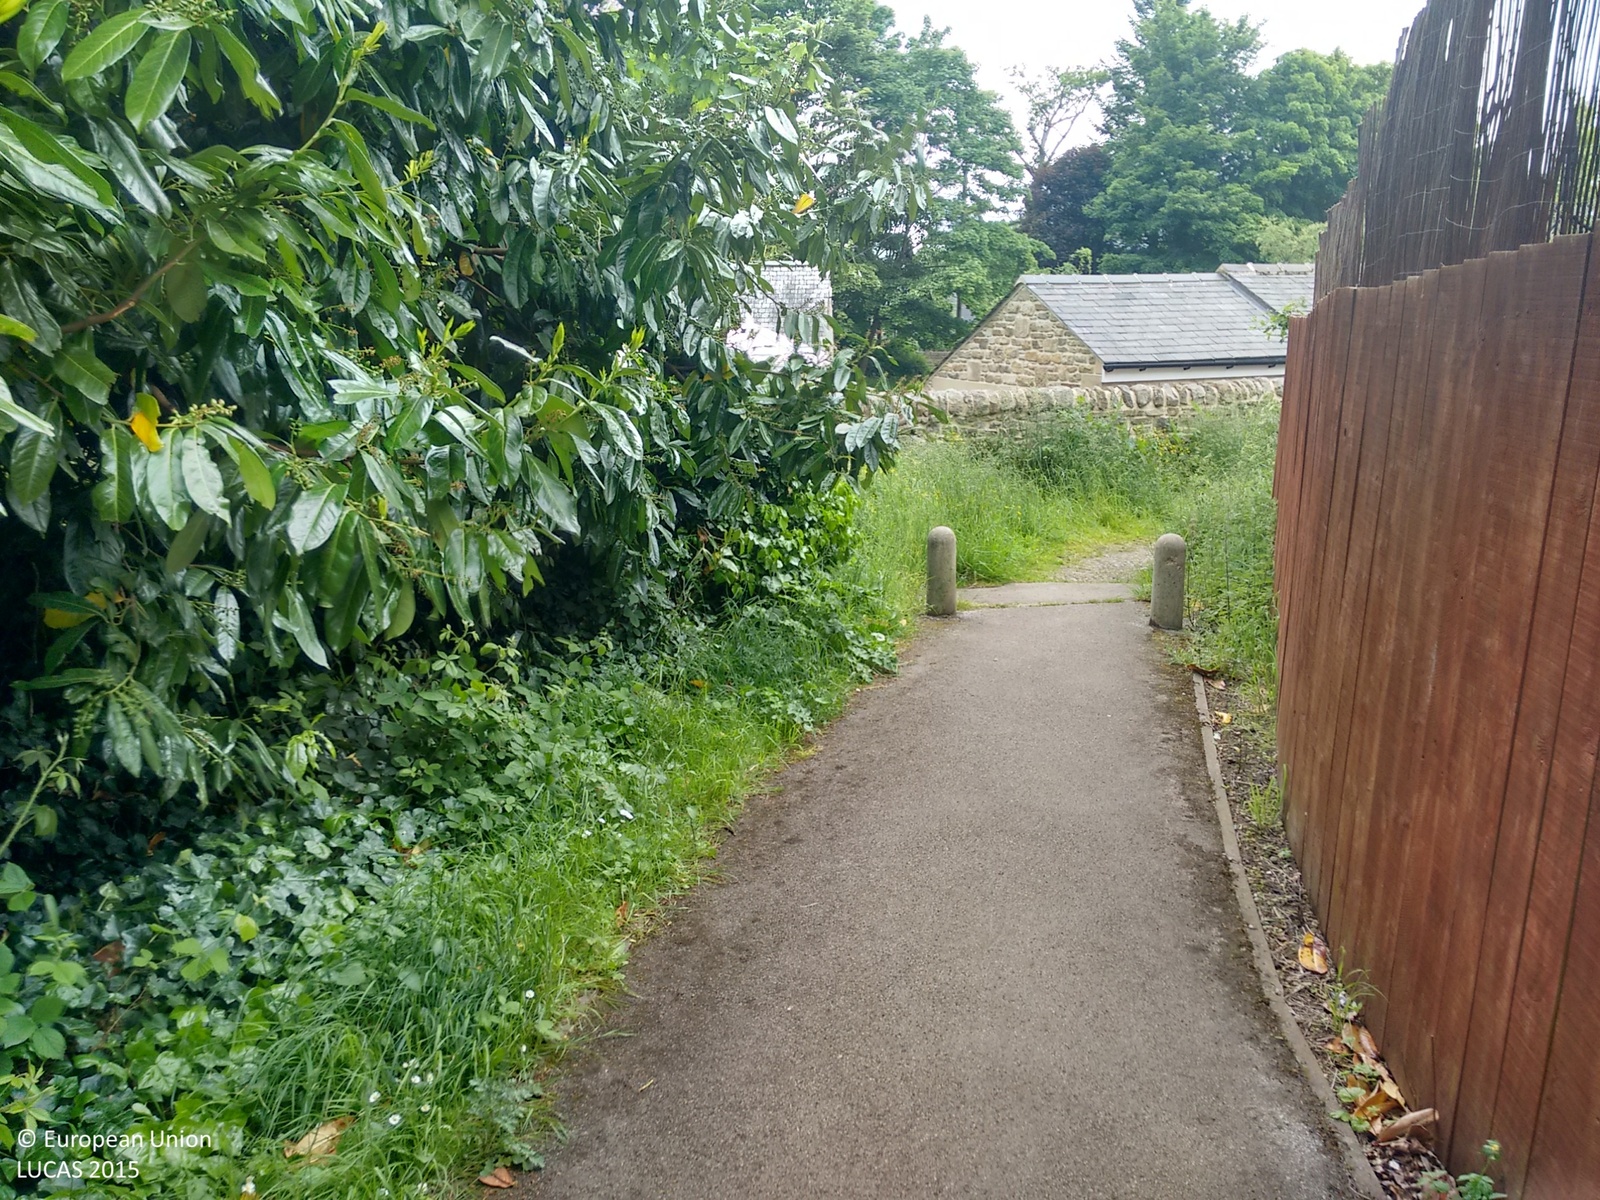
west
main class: Woodland
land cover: Broadleaved woodland
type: mesophytic deciduous forest
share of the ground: > 75 %
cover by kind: broadleaved forest trees 100 %
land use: Community services
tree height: > 5 m
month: June
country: GB
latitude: 54.8724
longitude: -1.8494
